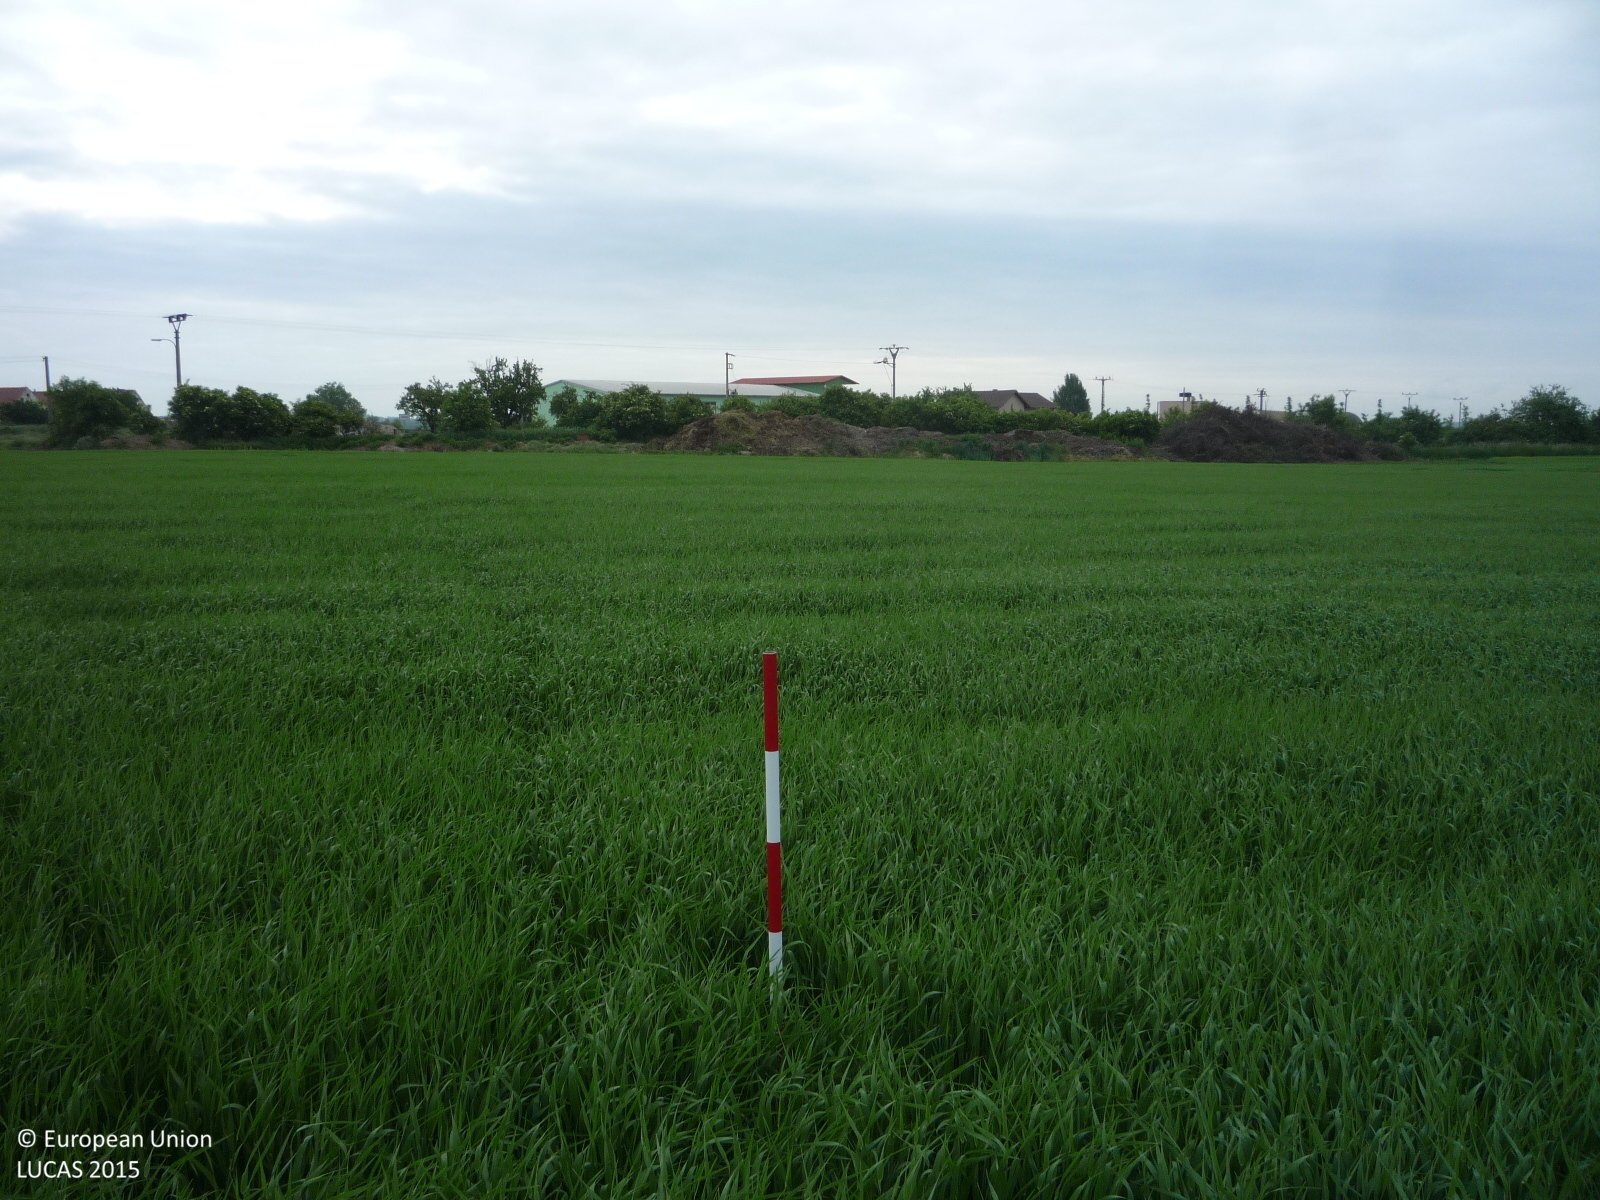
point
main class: Cropland
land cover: Barley
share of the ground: > 75 %
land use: Agriculture (excluding fallow land and kitchen gardens)
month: May
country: CZ
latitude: 50.4009
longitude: 14.5179
